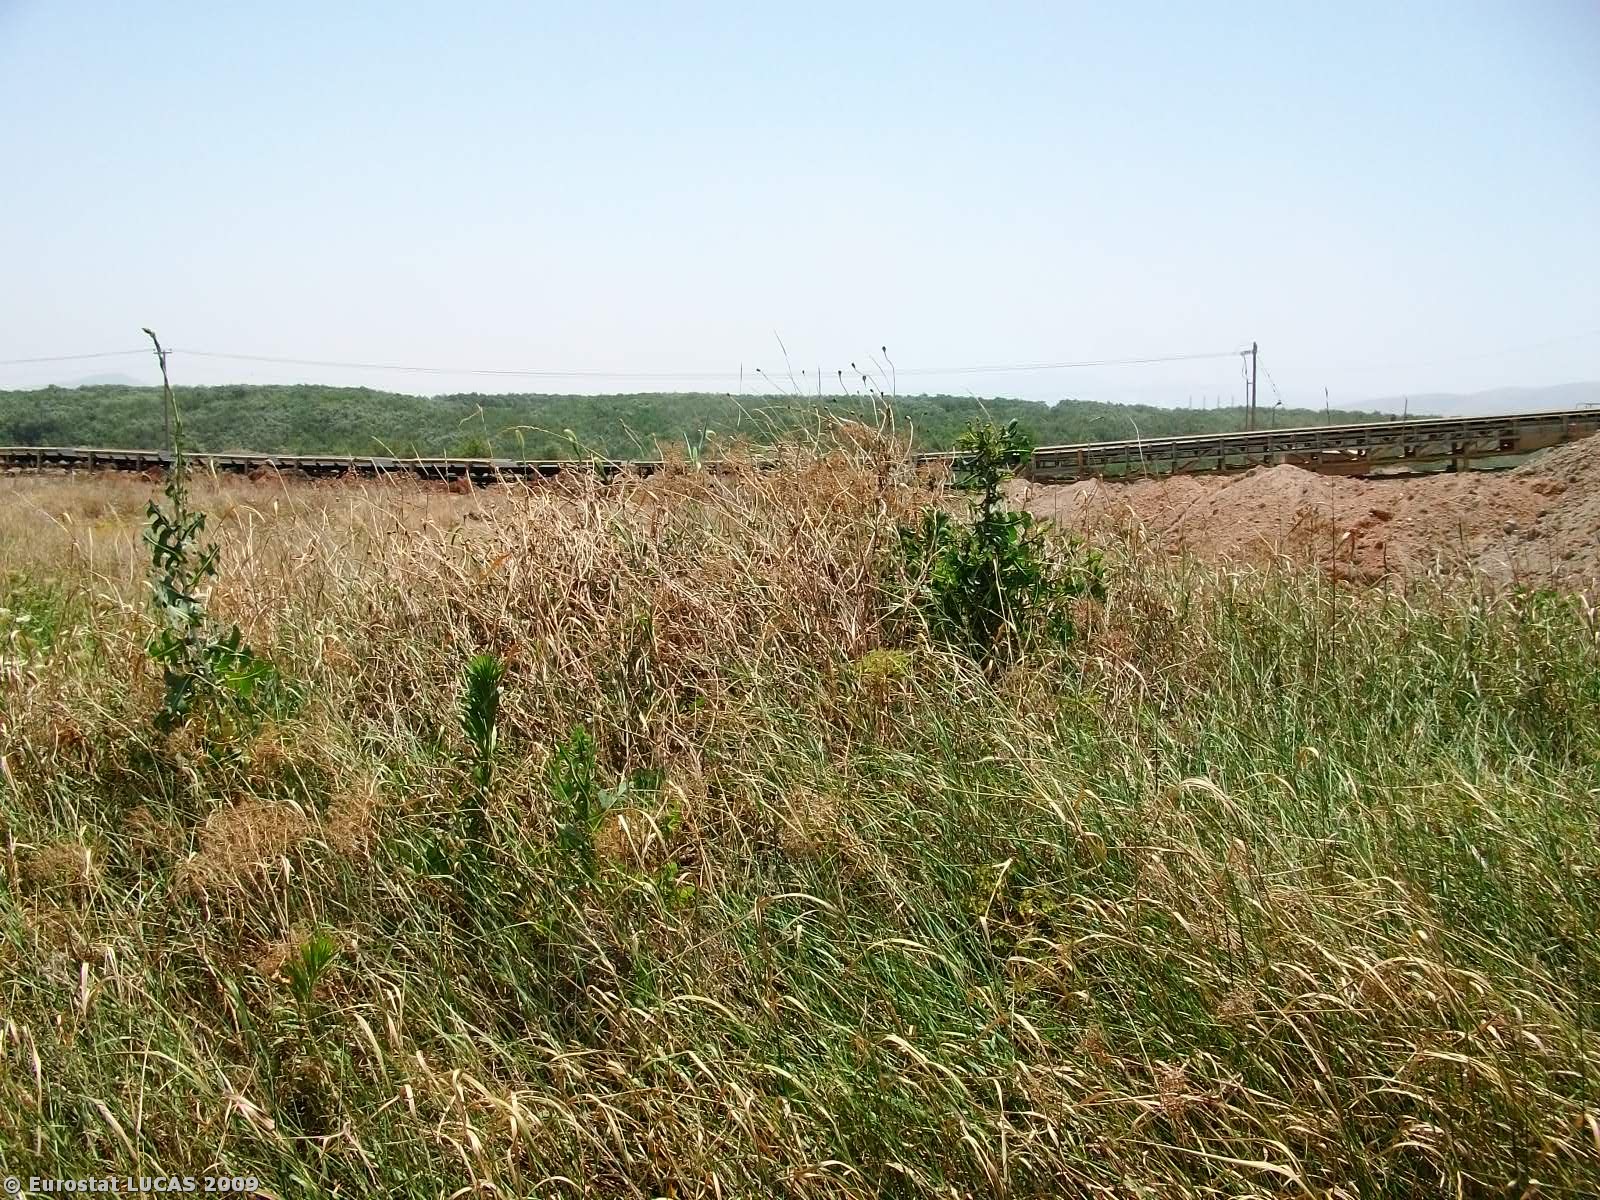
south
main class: Grassland
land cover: Grassland without tree/shrub cover
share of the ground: > 75 %
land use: Unused
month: July
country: GR
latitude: 40.4629
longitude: 21.8226
